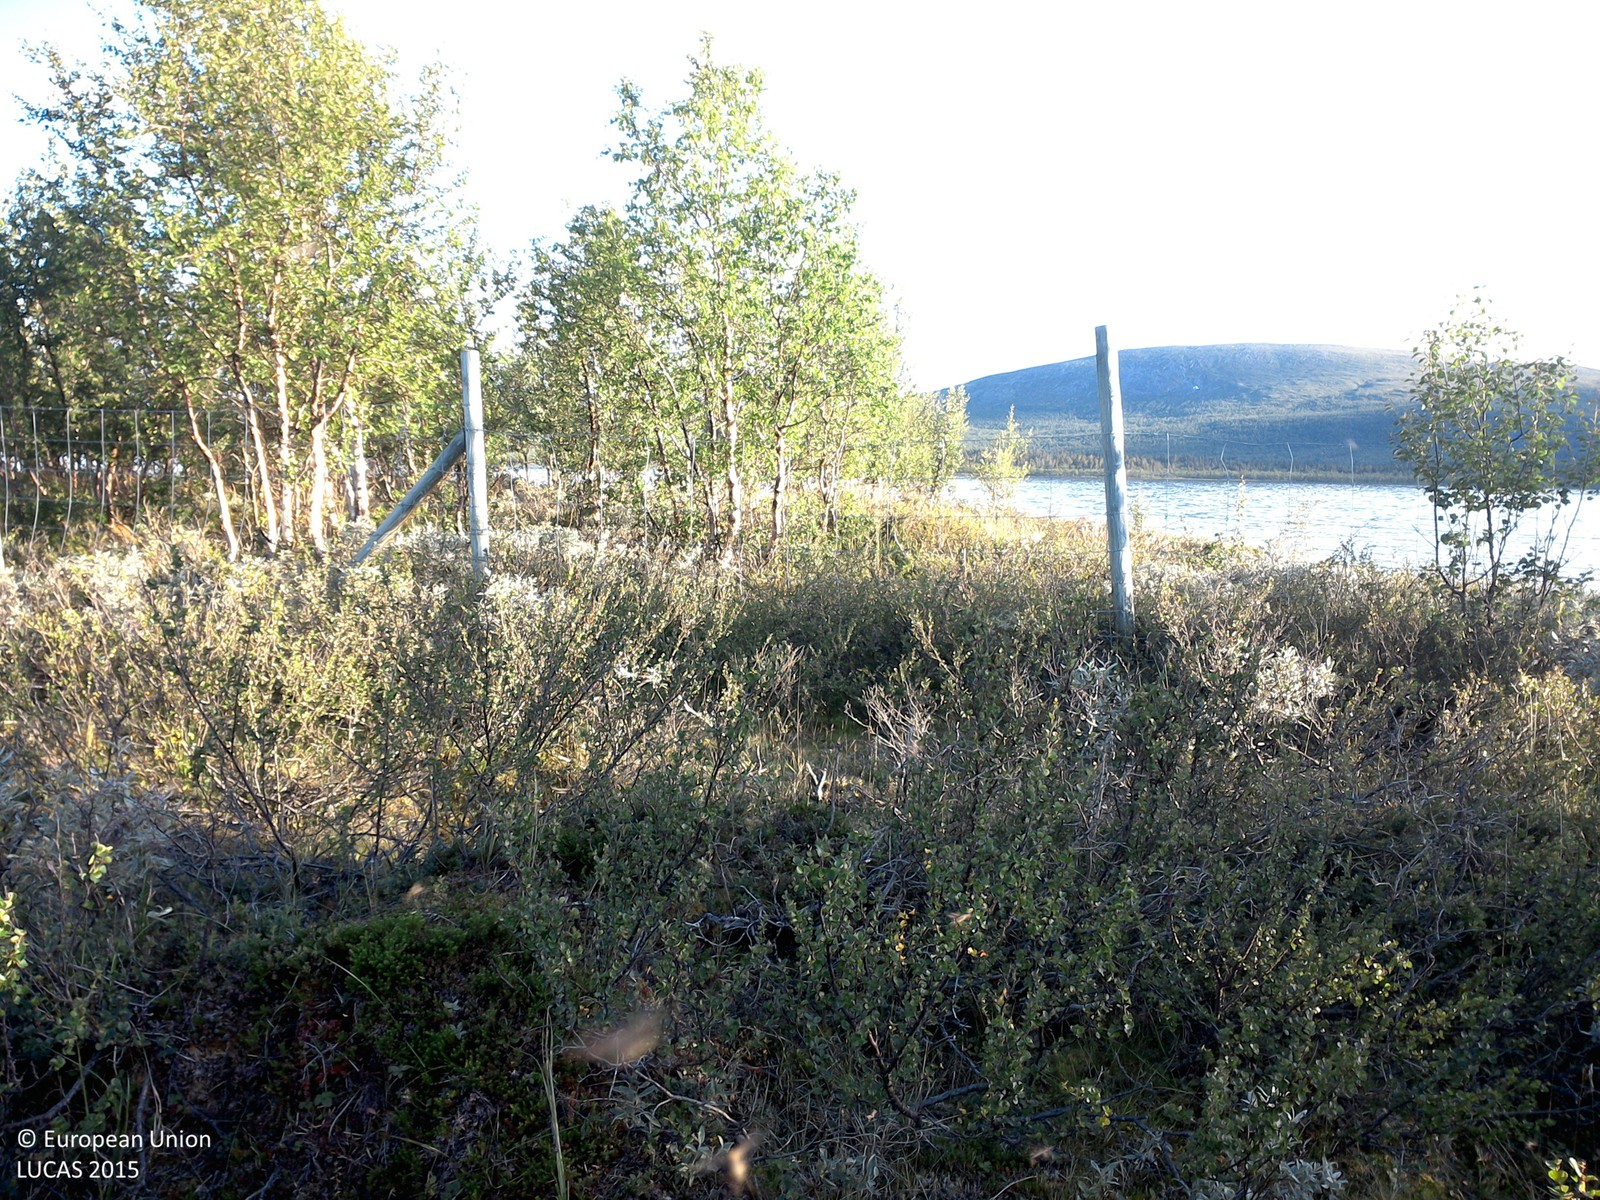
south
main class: Shrubland
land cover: Shrubland with sparse tree cover
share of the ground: > 75 %
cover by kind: shrubs 95 %, broadleaved forest trees 5 %
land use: Semi-natural and natural areas not in use
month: August
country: SE
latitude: 67.8599
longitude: 19.3770
